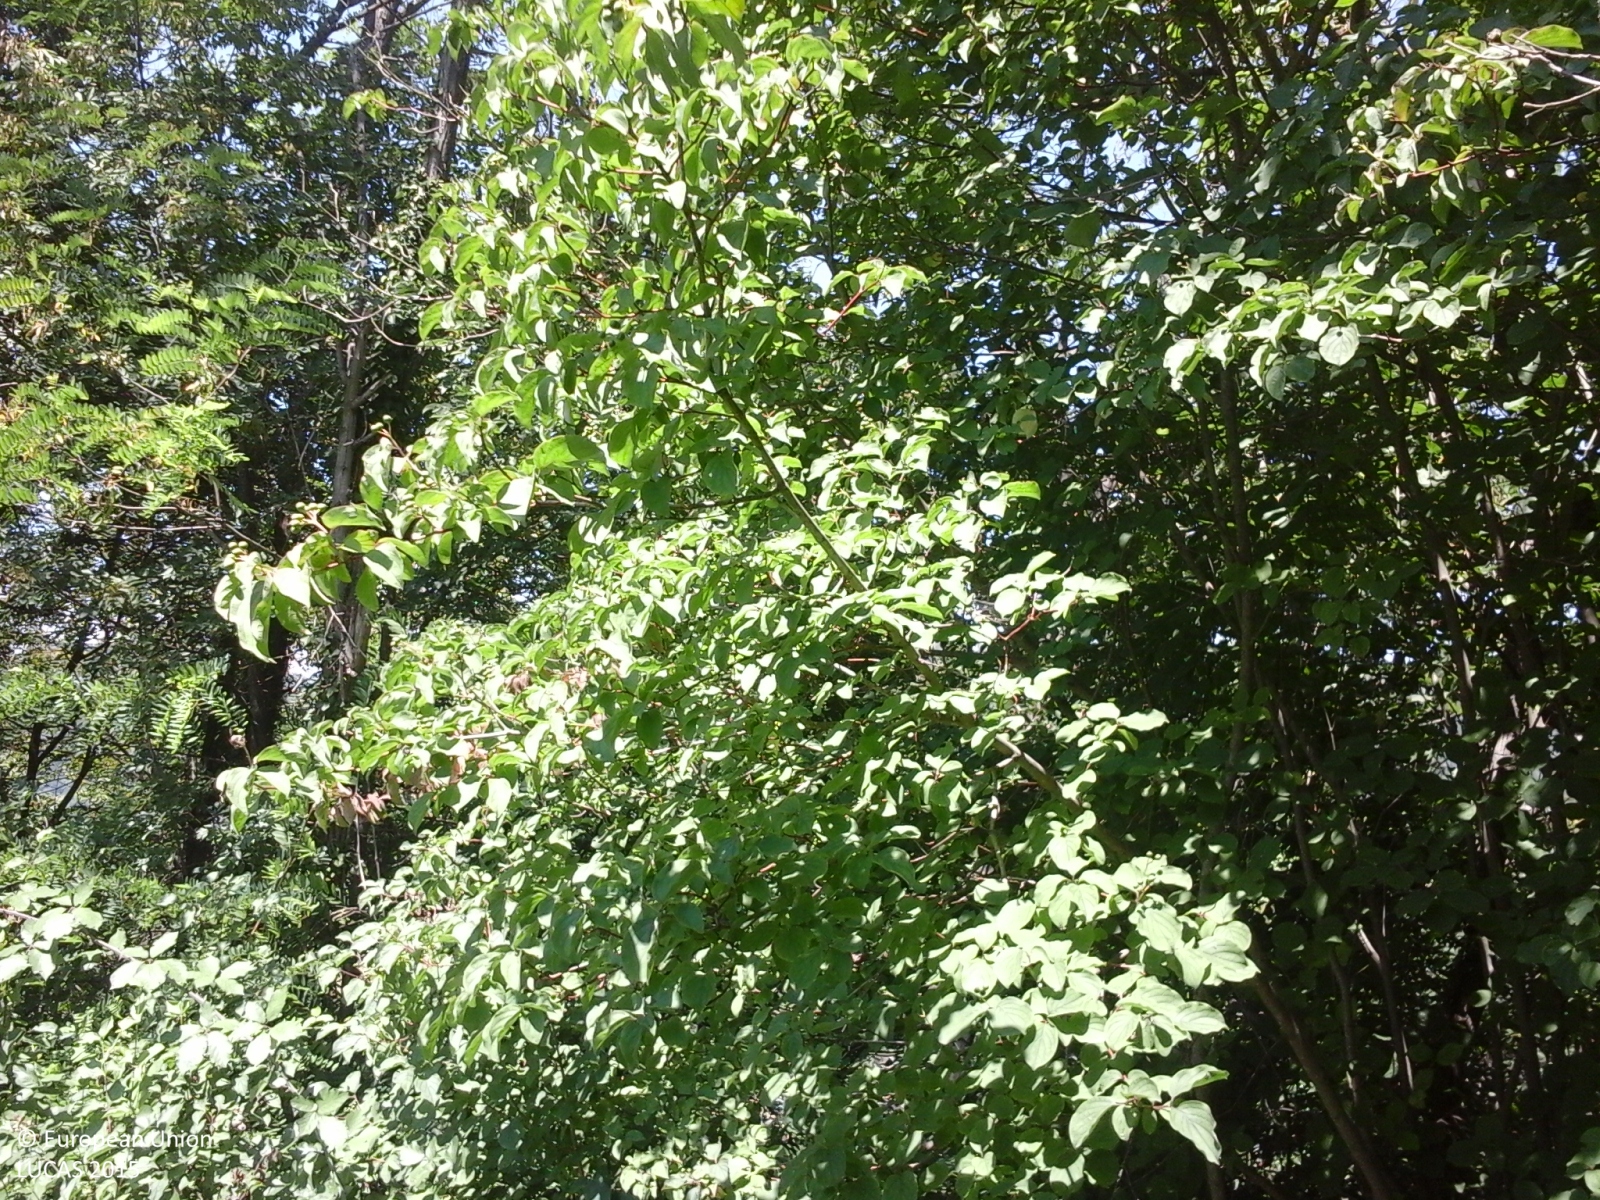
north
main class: Woodland
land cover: Broadleaved woodland
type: thermophilous deciduous forest
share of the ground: > 75 %
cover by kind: broadleaved forest trees 100 %
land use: Semi-natural and natural areas not in use
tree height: > 5 m
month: July
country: IT
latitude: 44.4221
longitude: 8.0323
